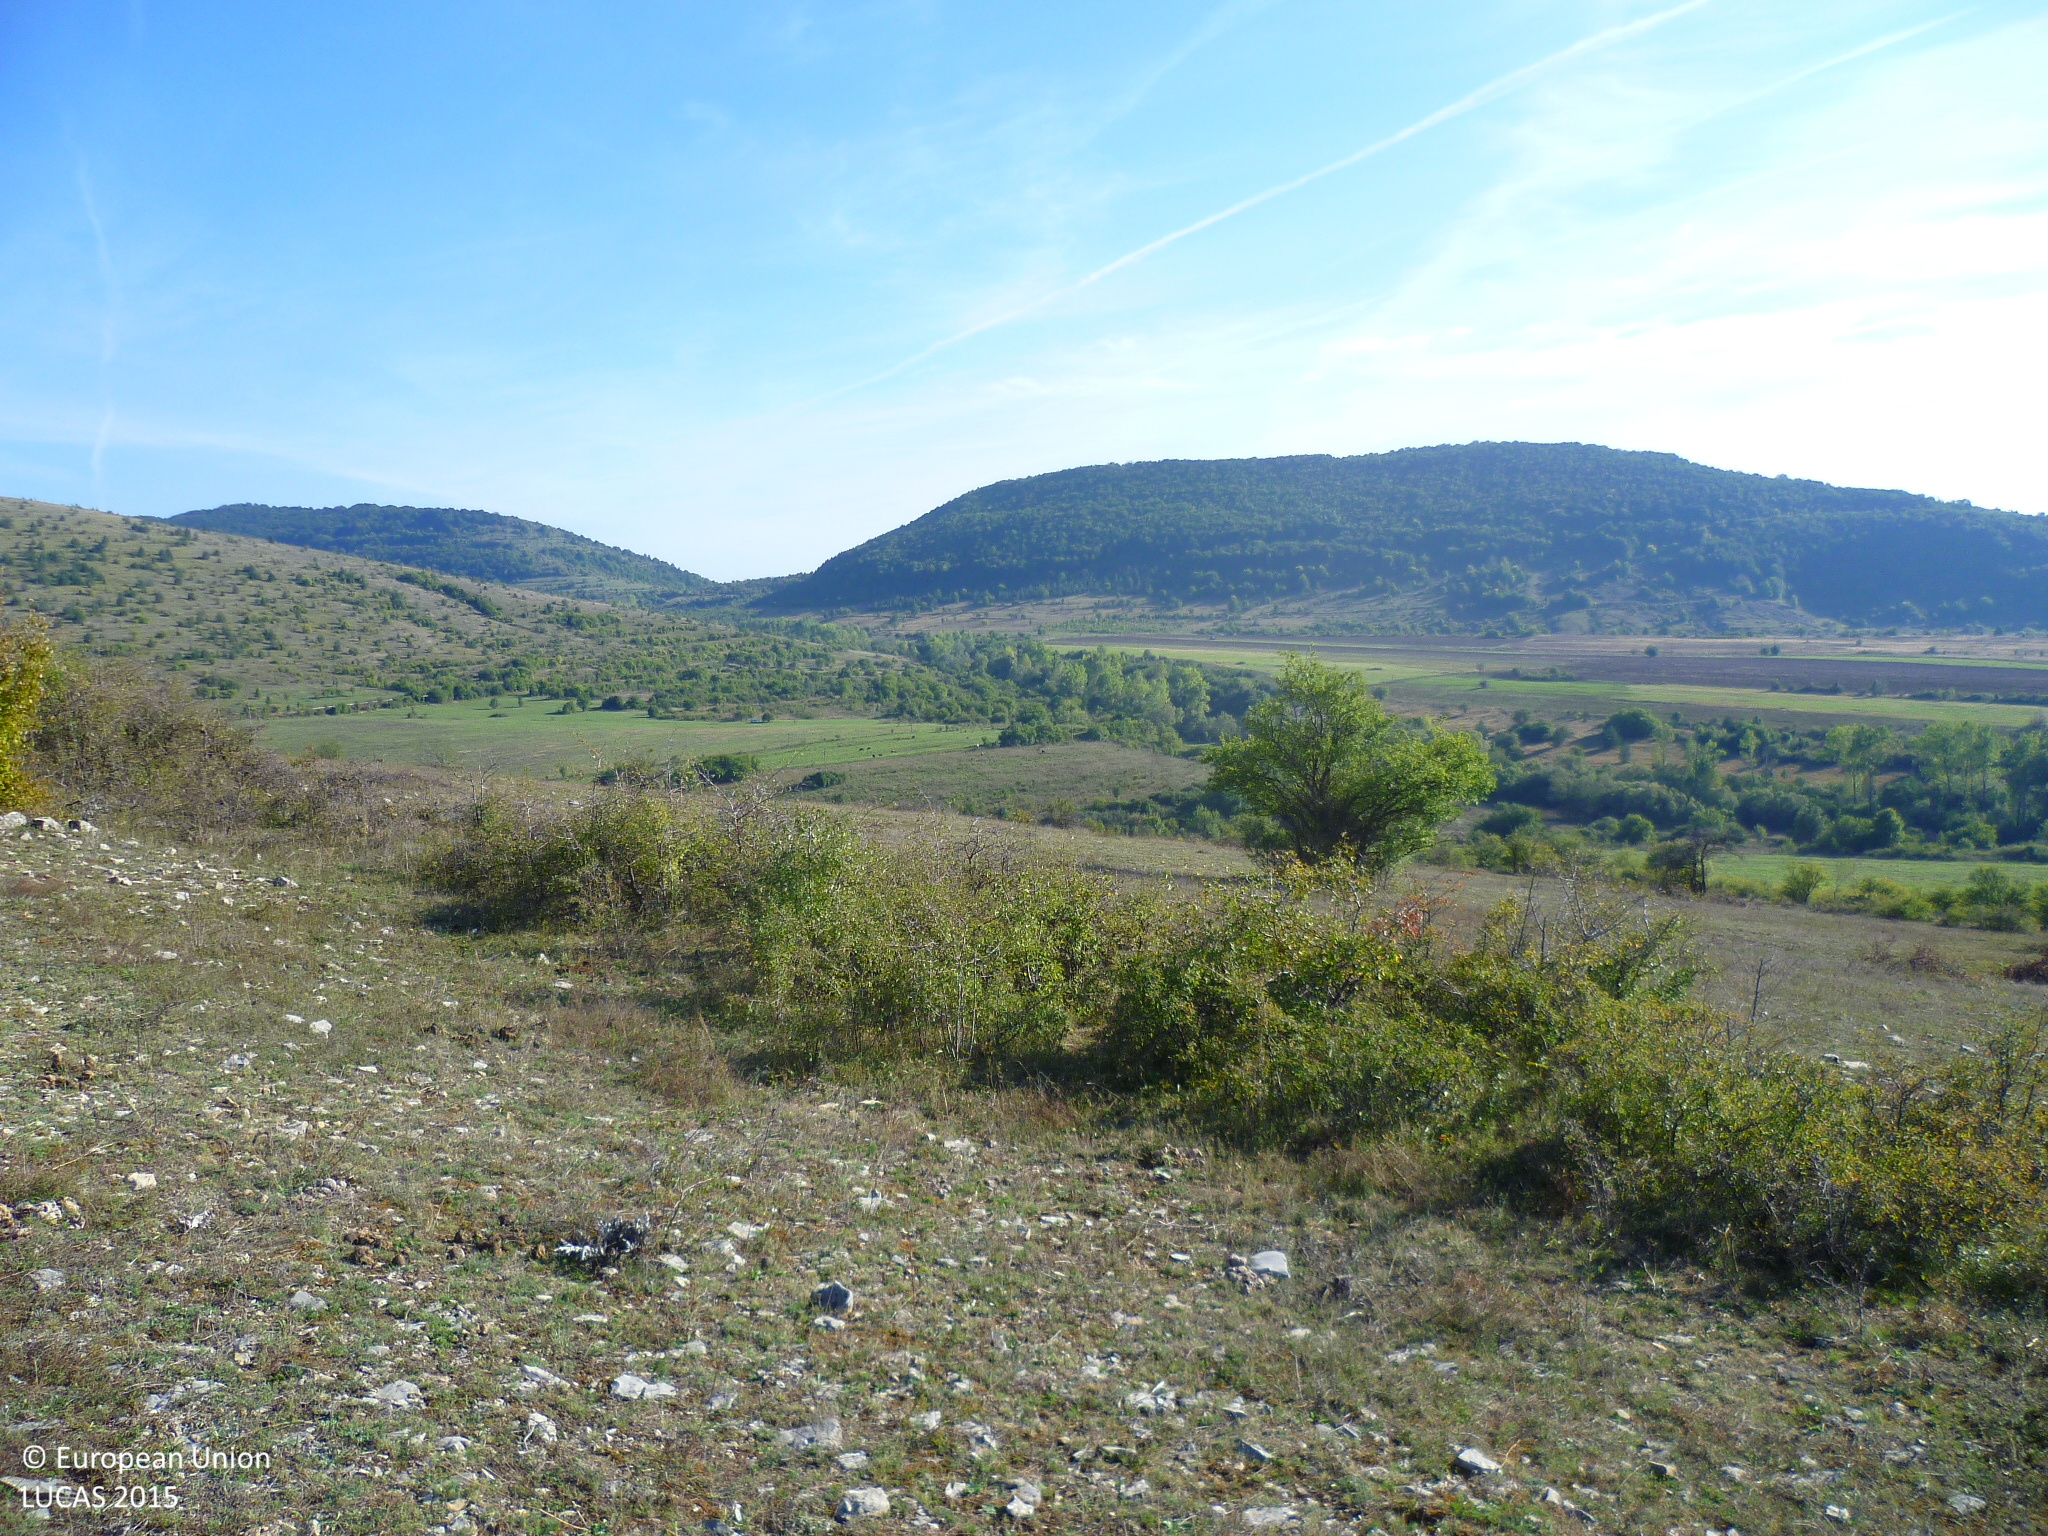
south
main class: Grassland
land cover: Grassland with sparse tree/shrub cover
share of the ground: > 75 %
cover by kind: herbaceous plants 65 %, unconsolidated bare surface 20 %, shrubs 10 %, broadleaved forest trees 5 %
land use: Agriculture (excluding fallow land and kitchen gardens)
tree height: < 5 m
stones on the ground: 25 - 50 %
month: October
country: BG
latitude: 43.0769
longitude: 22.9659
